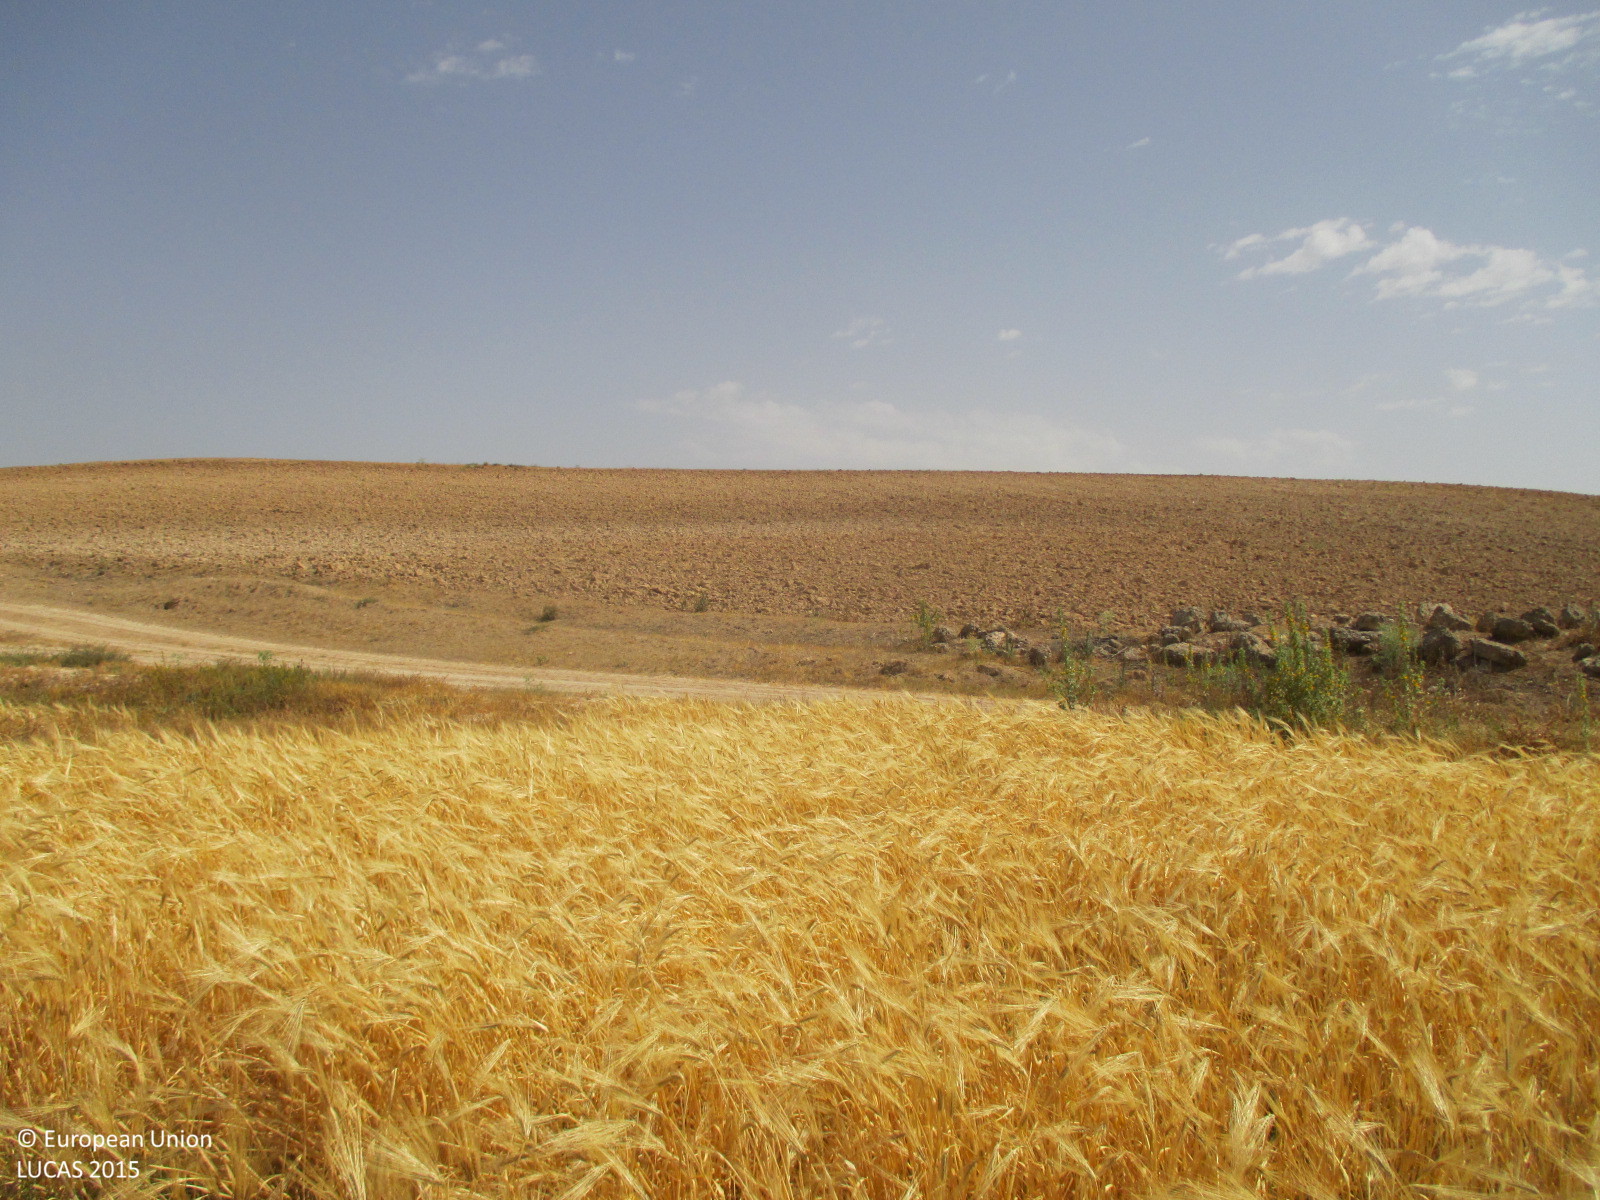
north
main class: Cropland
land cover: Barley
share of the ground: > 75 %
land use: Agriculture (excluding fallow land and kitchen gardens)
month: July
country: ES
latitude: 37.7932
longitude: -2.2637
